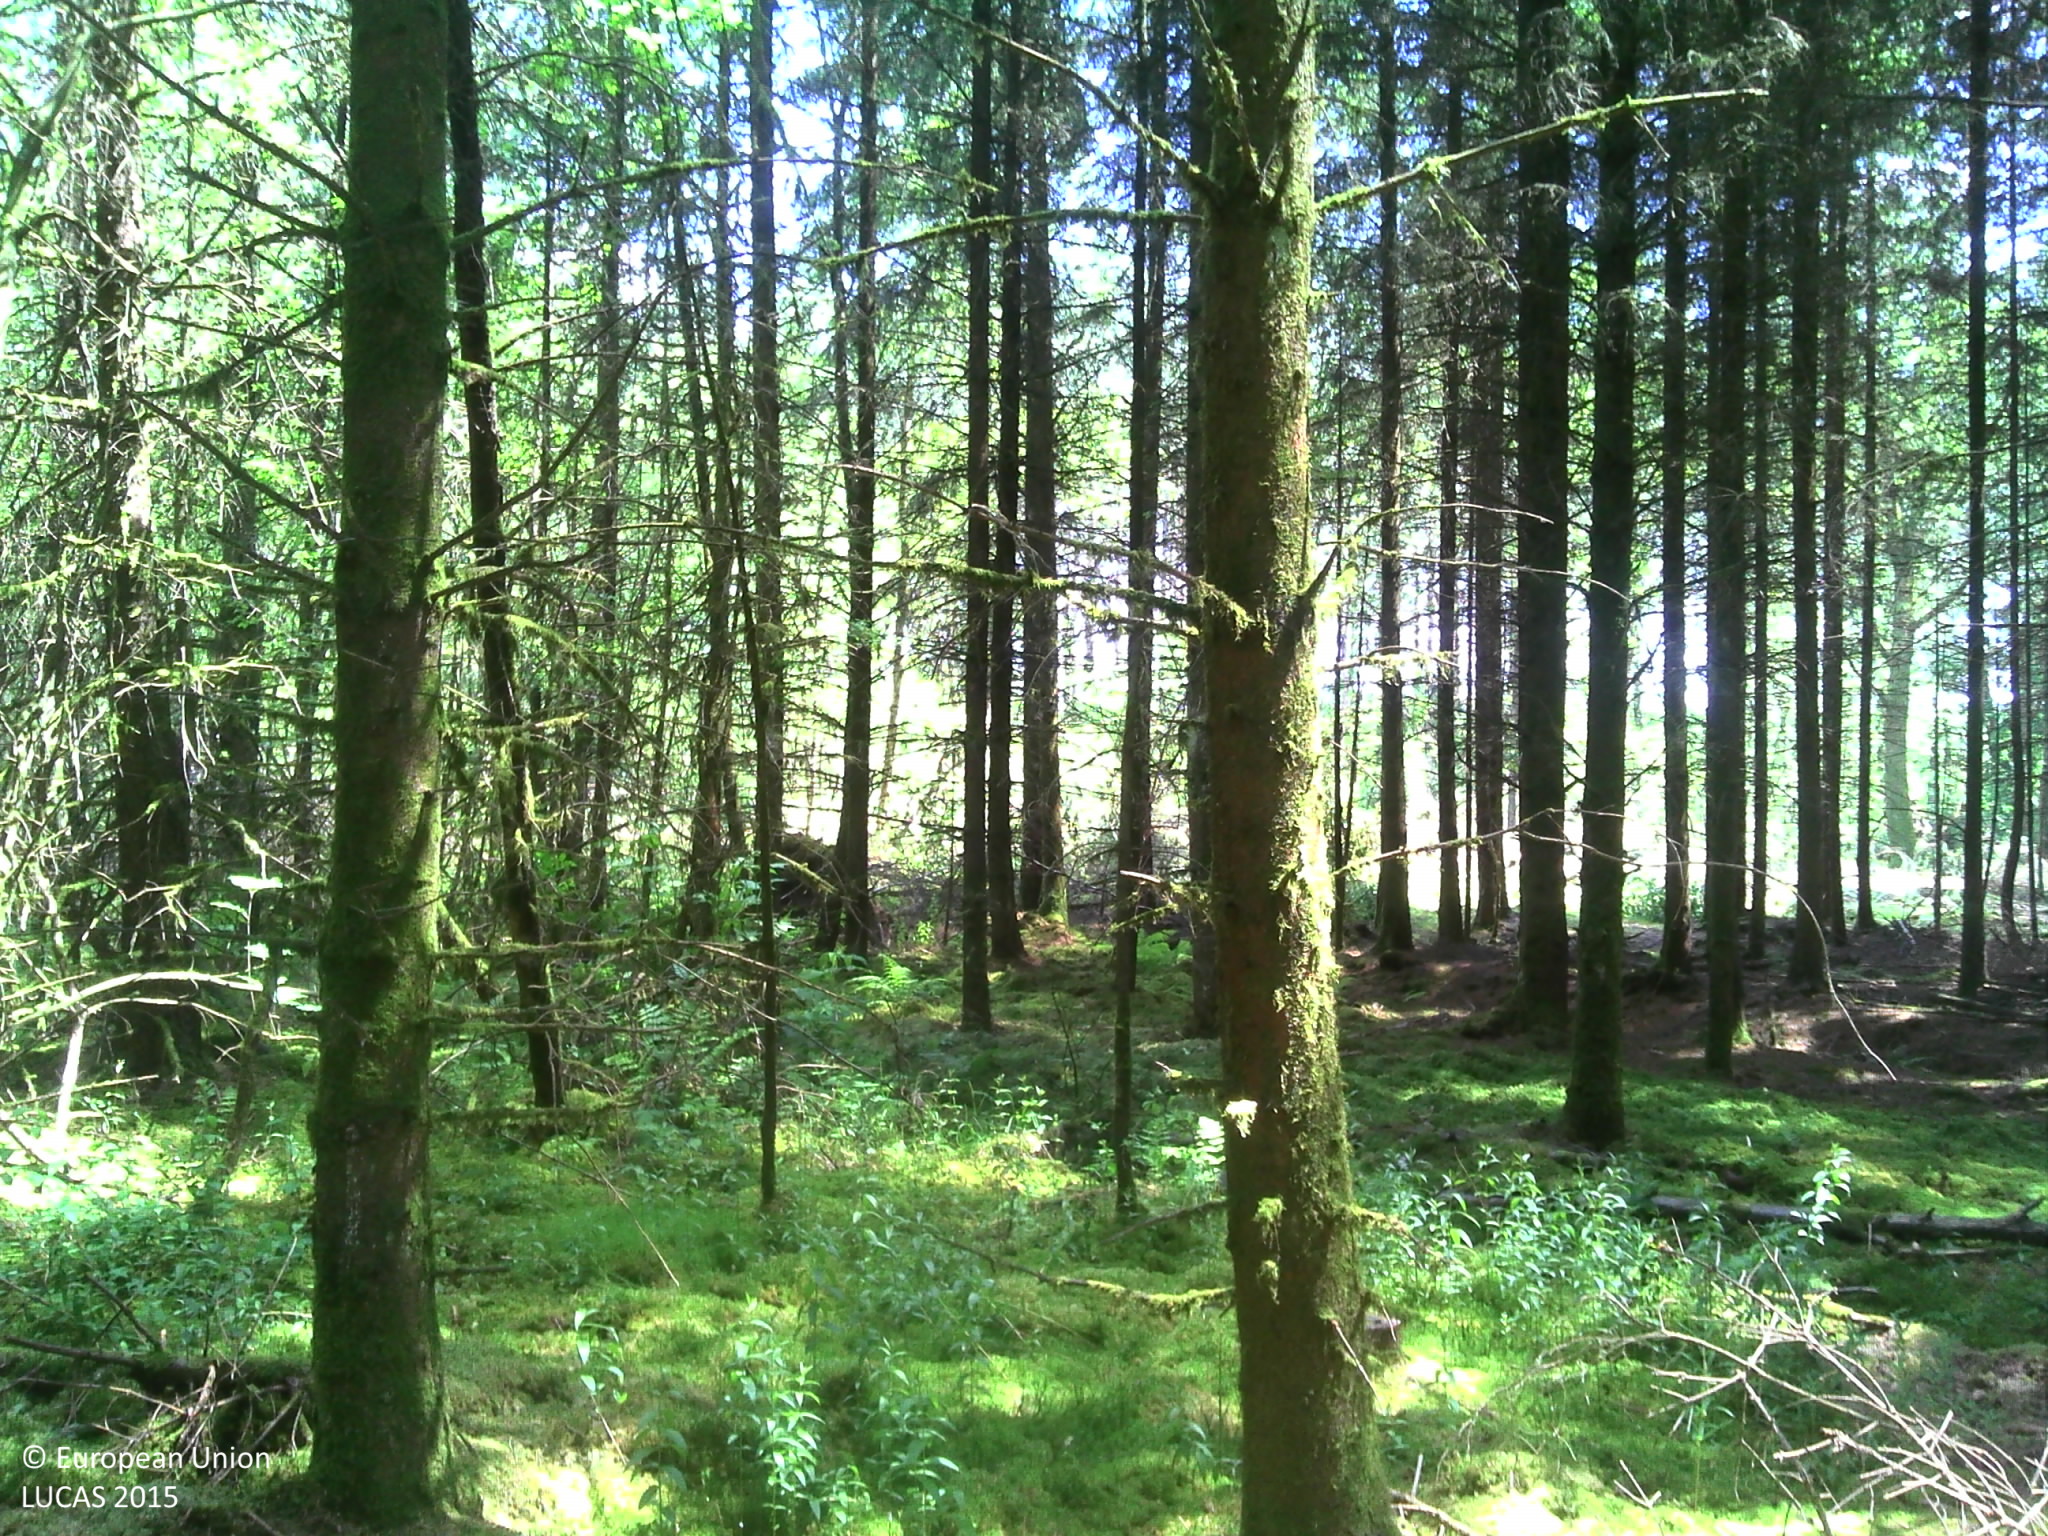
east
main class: Woodland
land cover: Spruce dominated coniferous woodland
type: exotic forest
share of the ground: > 75 %
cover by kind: coniferous forest trees 90 %, herbaceous plants 5 %, lichens and mosses 5 %
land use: Forestry
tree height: > 5 m
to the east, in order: Spruce dominated coniferous woodland; Ditches and canals; Spruce dominated coniferous woodland; Ditches and canals; Spruce dominated coniferous woodland; Ditches and canals; Other bare soil; Ditches and canals; Other bare soil; Ditches and canals; Broadleaved woodland; Ditches and canals; Broadleaved woodland; Nurseries; Tracks; Nurseries; Tracks; Nurseries
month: June
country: BE
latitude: 49.9596
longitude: 4.4620
